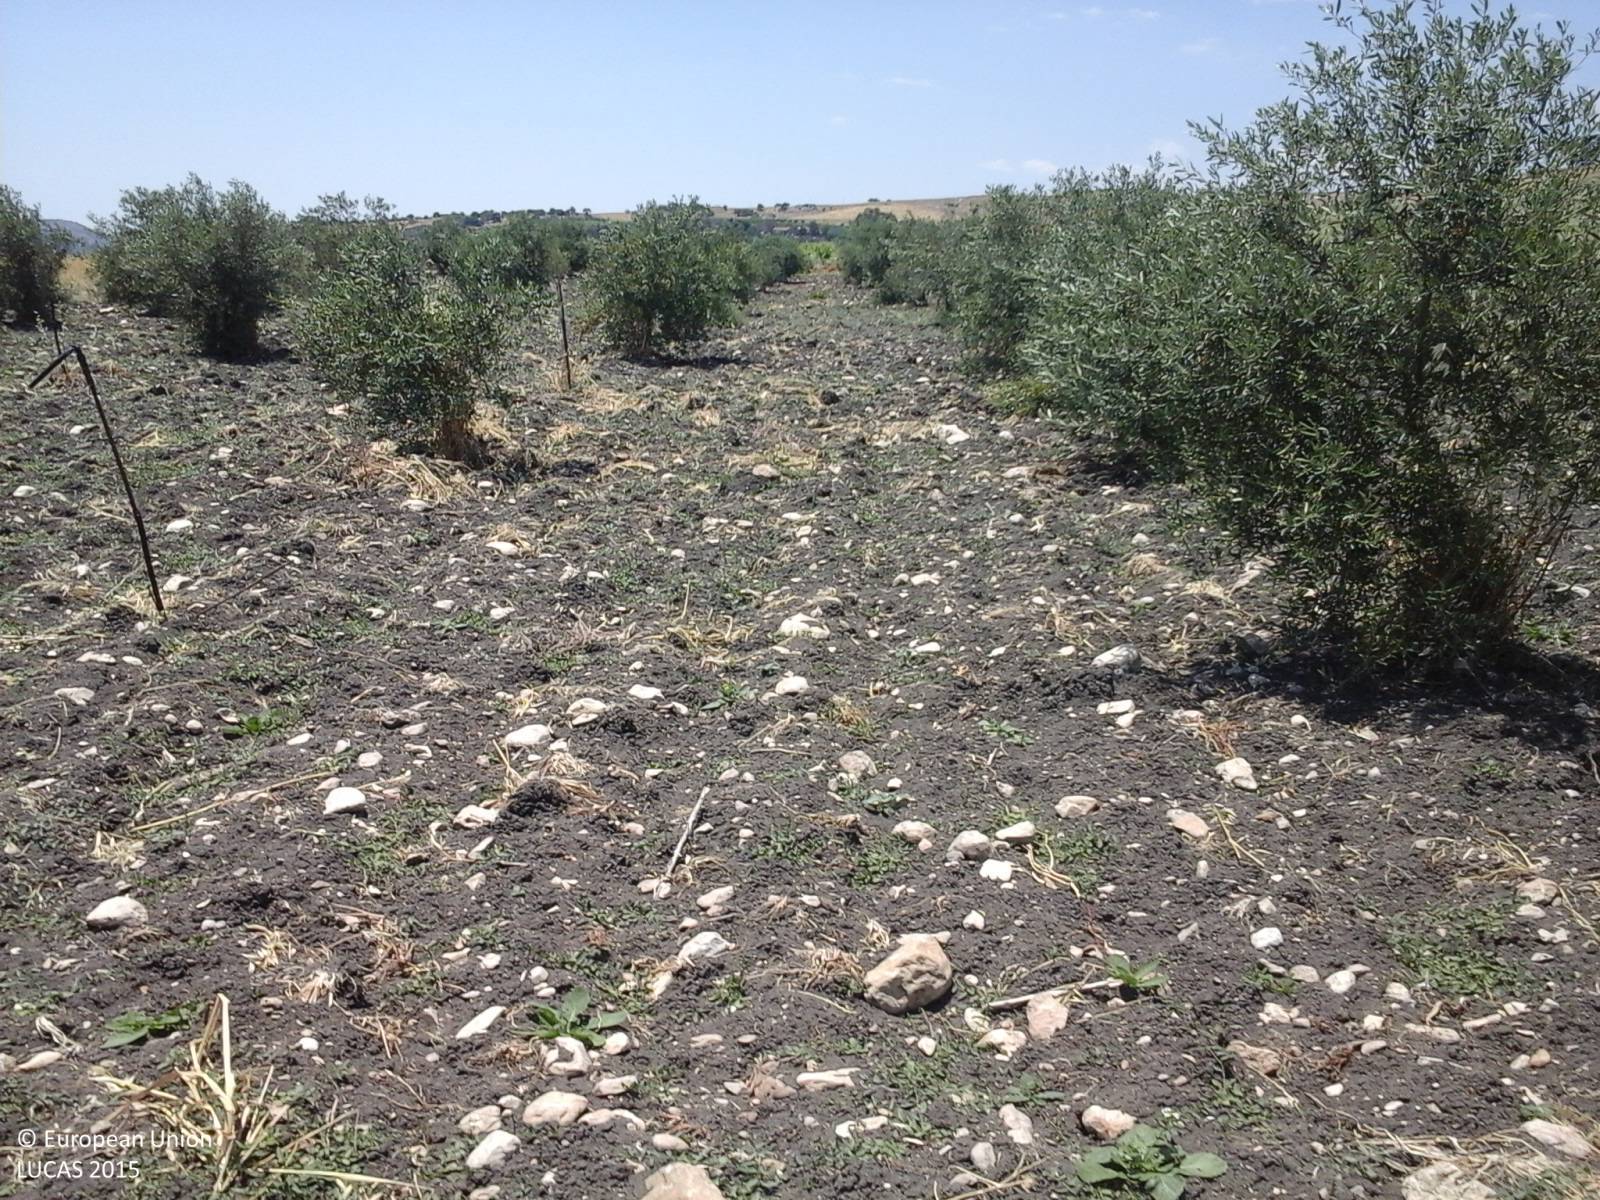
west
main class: Cropland
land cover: Olive groves
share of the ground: 10 - 25 %
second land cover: Other bare soil
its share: > 75 %
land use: Agriculture (excluding fallow land and kitchen gardens)
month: July
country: IT
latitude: 37.6579
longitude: 13.1840
